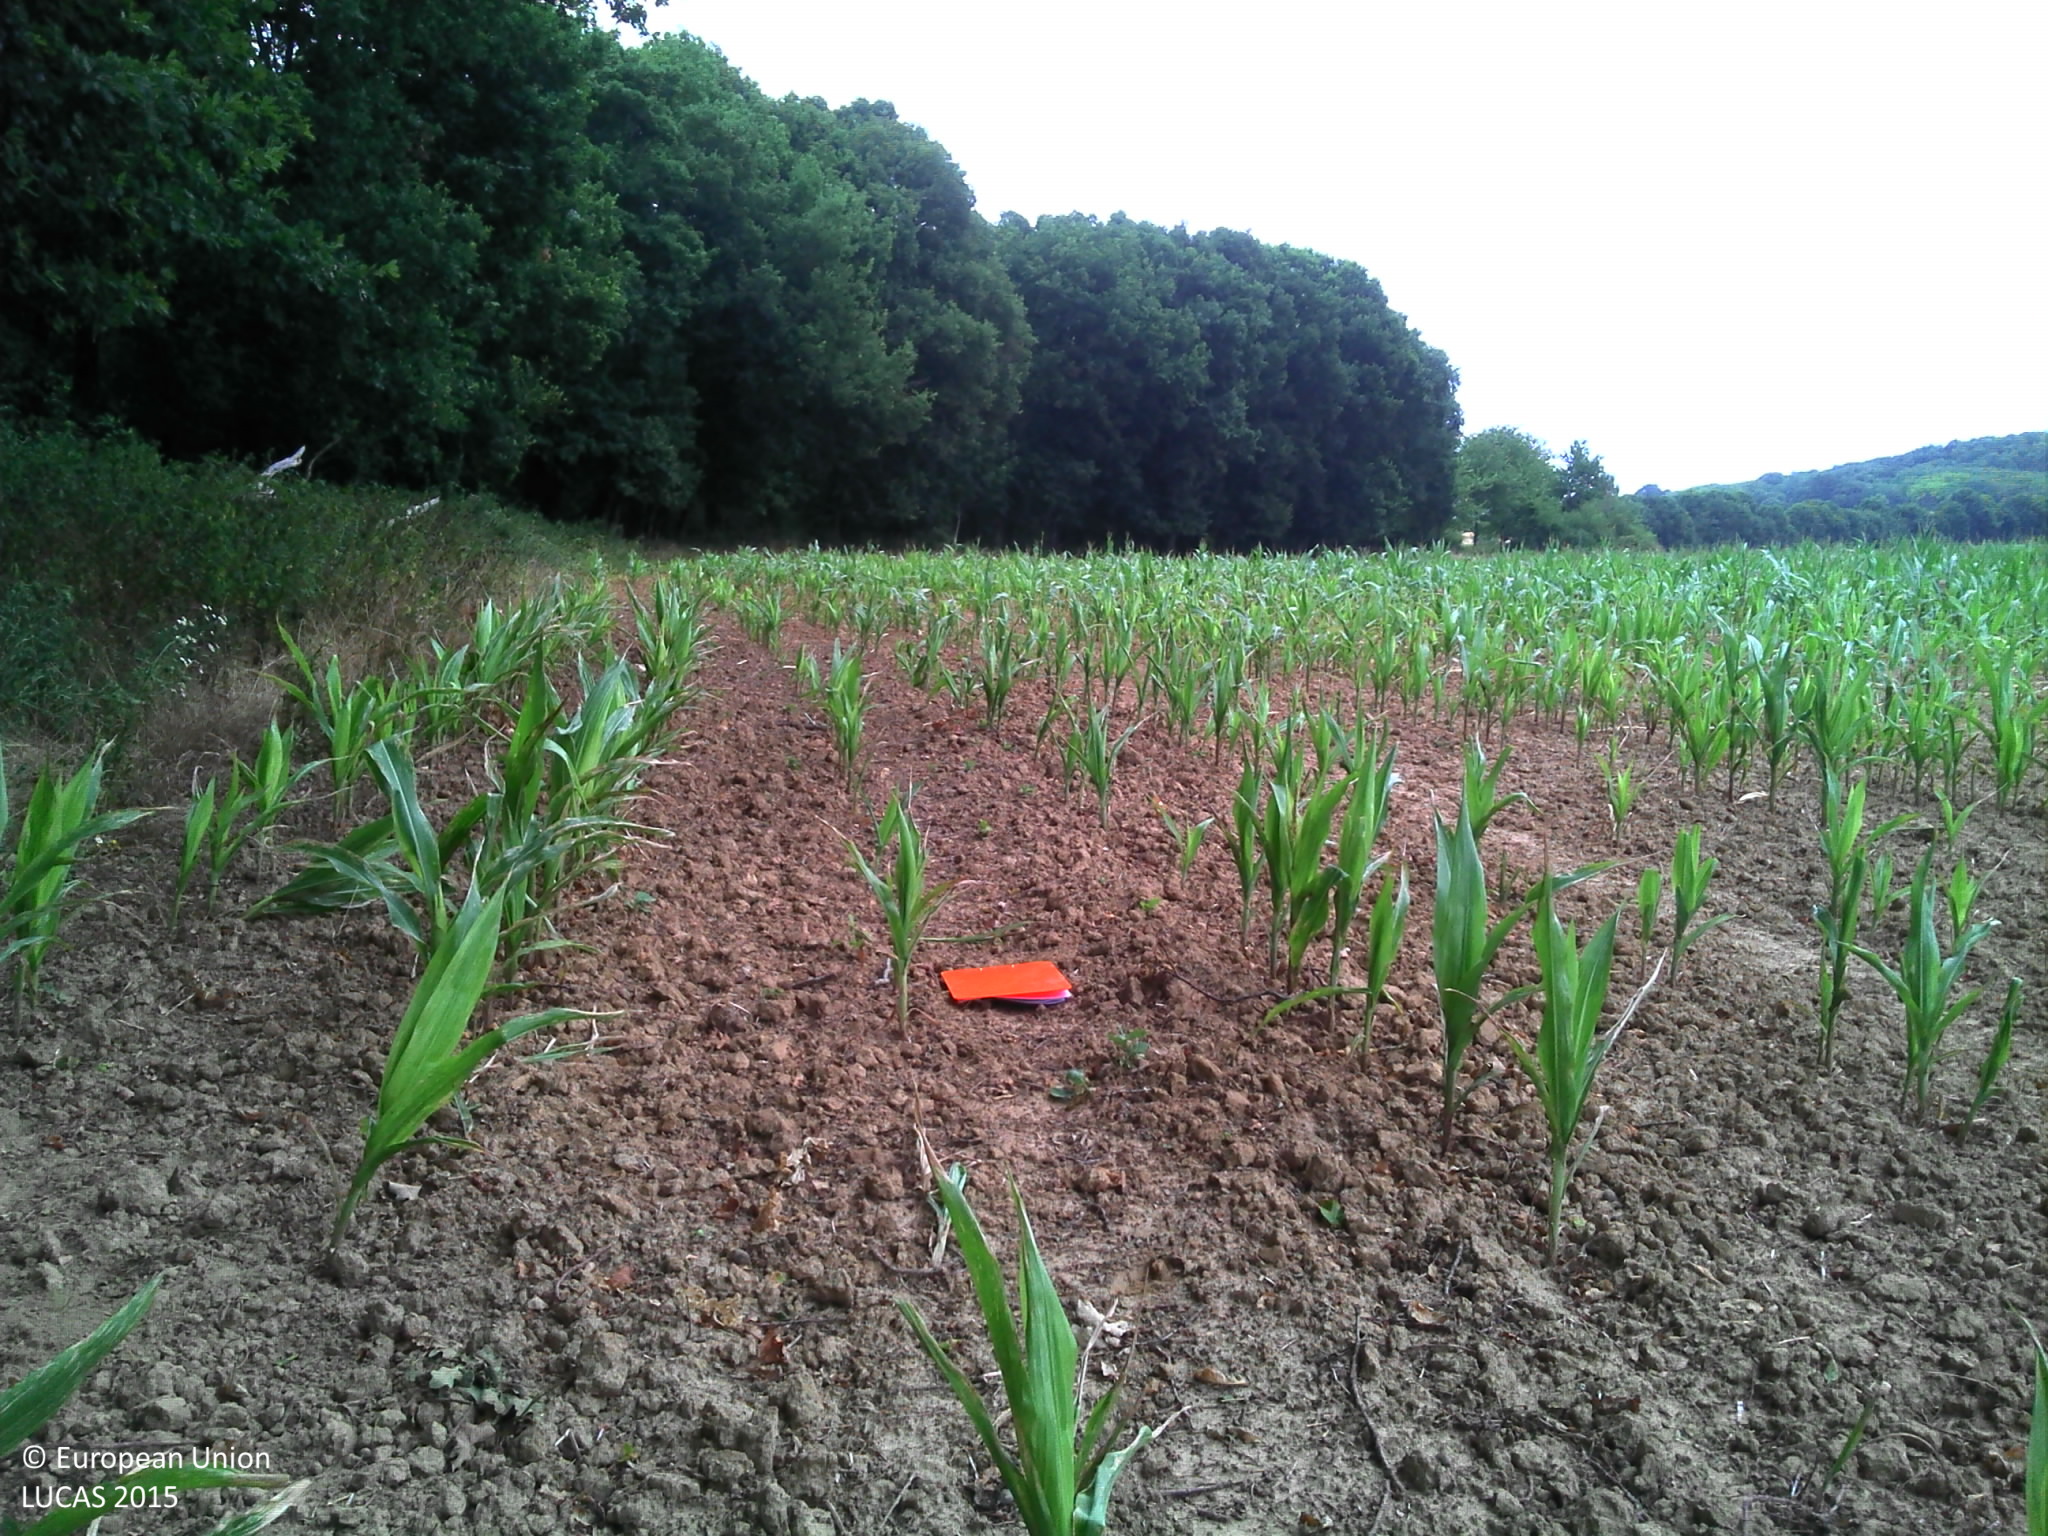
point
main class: Cropland
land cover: Maize
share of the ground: 10 - 25 %
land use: Agriculture (excluding fallow land and kitchen gardens)
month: July
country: FR
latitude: 48.4387
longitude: 2.5144
